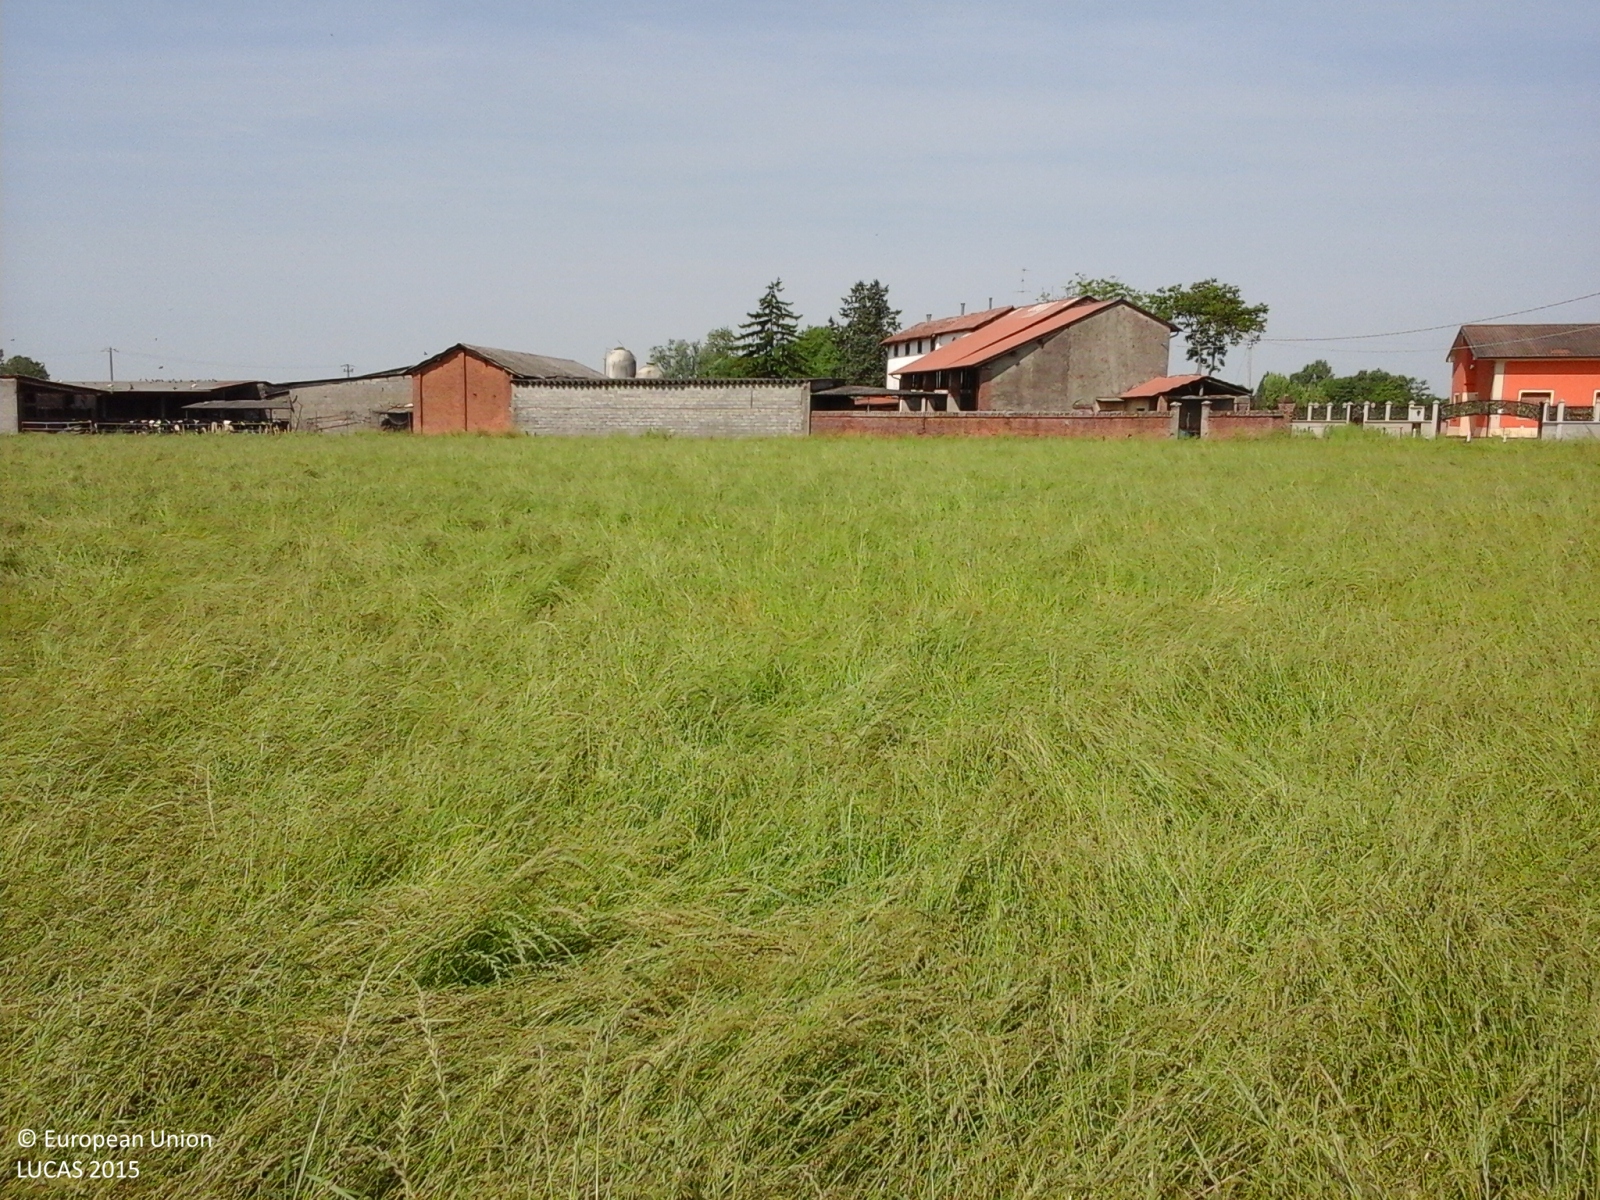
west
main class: Cropland
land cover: Temporary grasslands
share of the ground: > 75 %
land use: Agriculture (excluding fallow land and kitchen gardens)
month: May
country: IT
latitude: 45.3962
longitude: 9.8597
